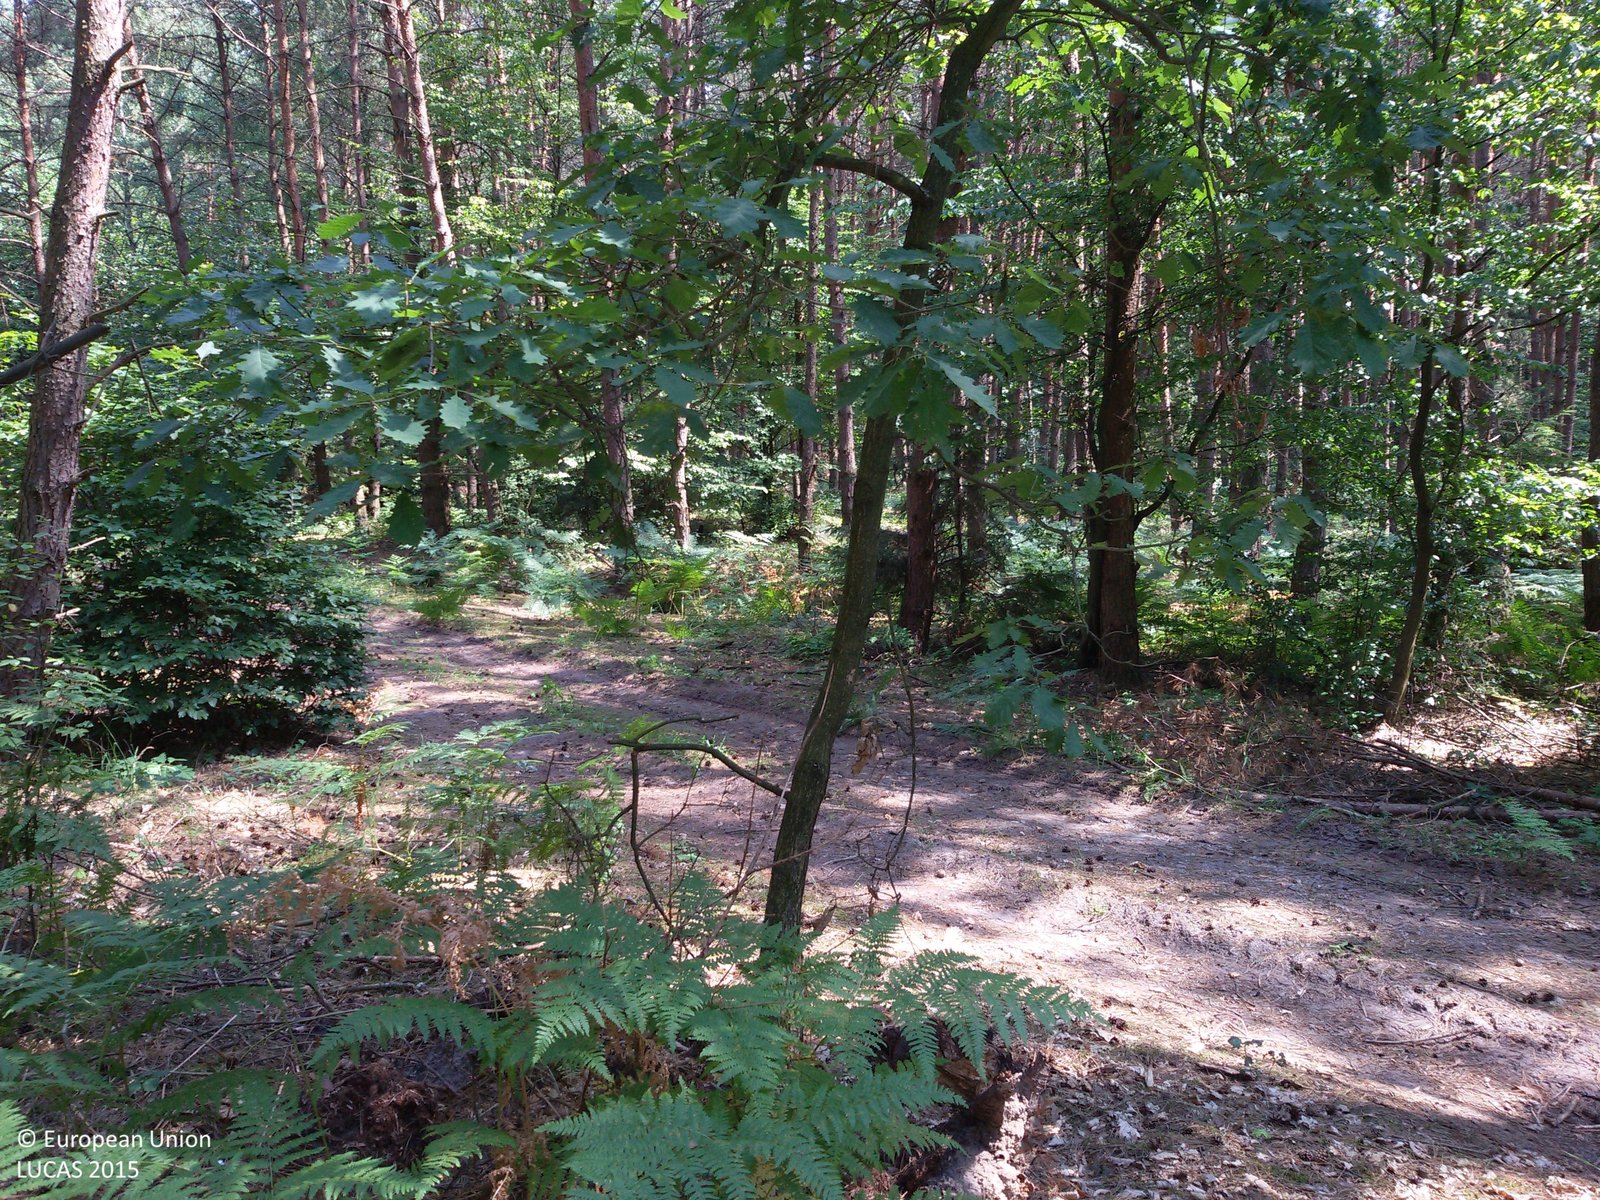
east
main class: Woodland
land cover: Pine dominated coniferous woodland
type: hemiboreal forest and nemoral coniferous forest and mixed broadleaved-coniferous forest
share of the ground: > 75 %
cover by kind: coniferous forest trees 100 %
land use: Forestry
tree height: > 5 m
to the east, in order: Pine dominated coniferous woodland; Tracks; Pine dominated mixed woodland; Tracks; Pine dominated mixed woodland
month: July
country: PL
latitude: 53.2685
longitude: 17.6446
